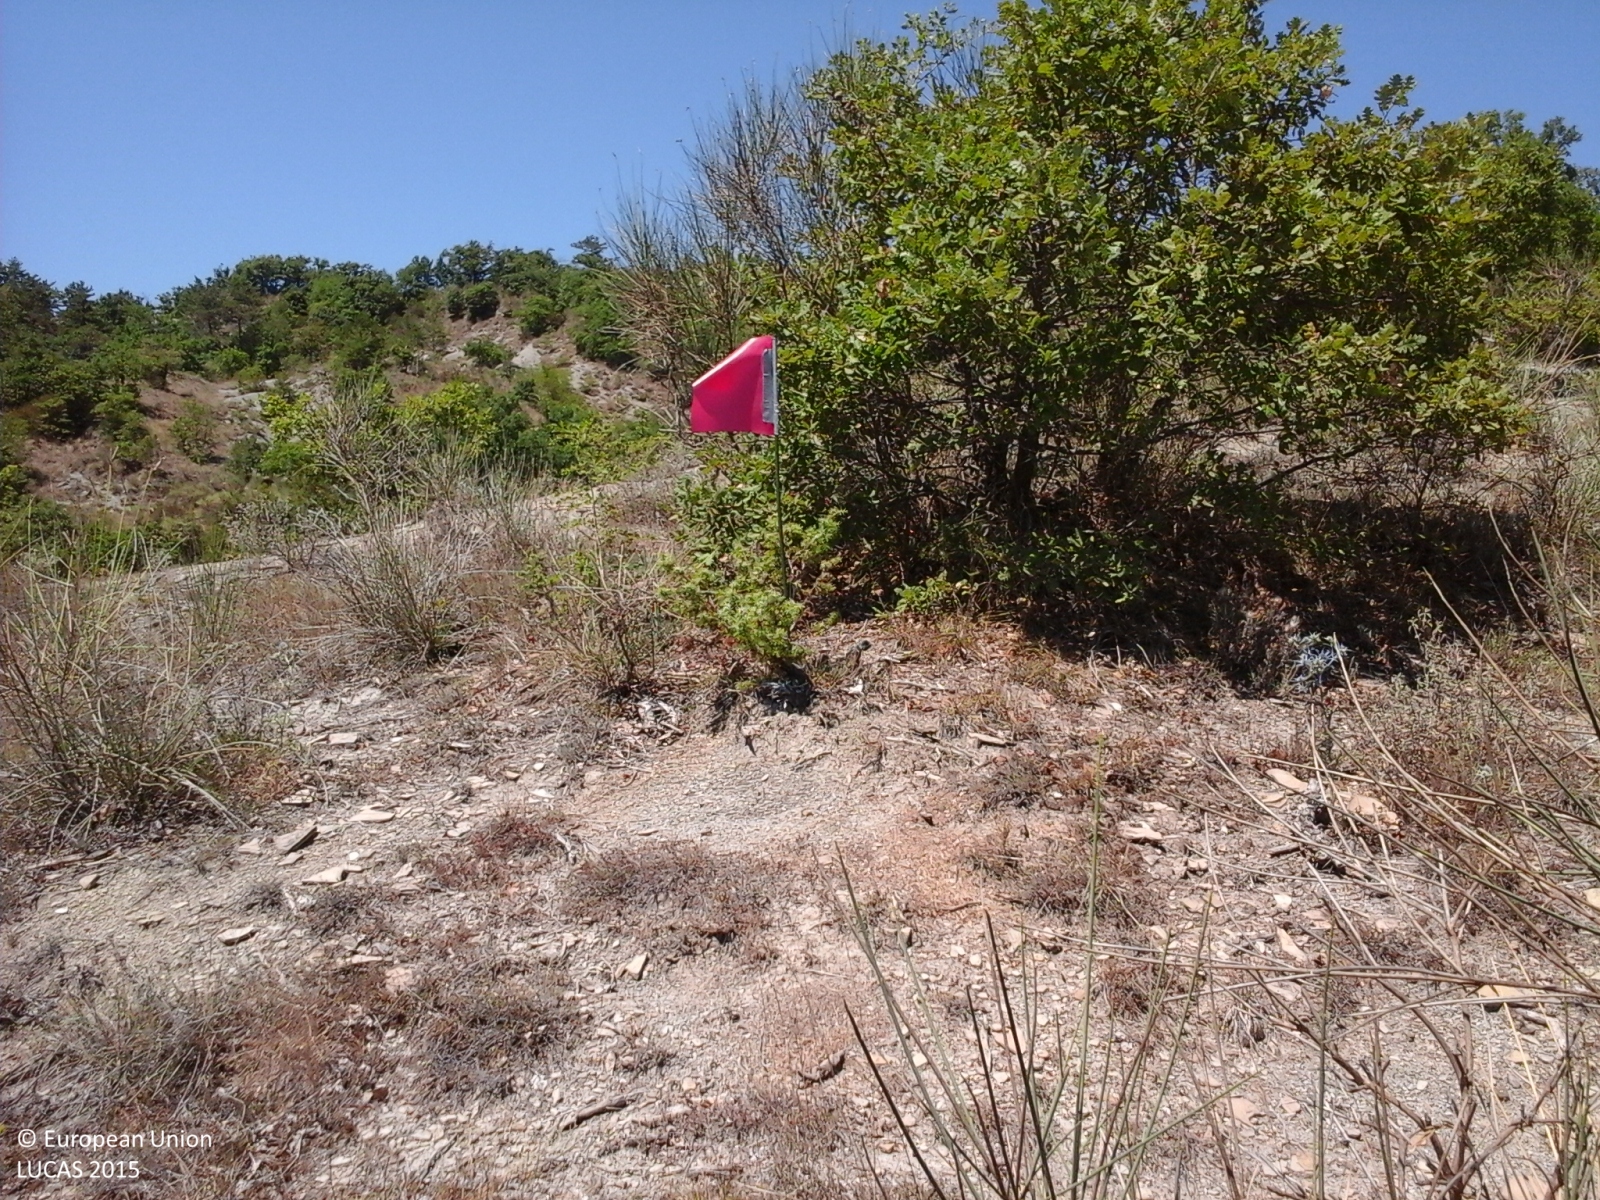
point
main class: Shrubland
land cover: Shrubland with sparse tree cover
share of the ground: > 75 %
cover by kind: shrubs 95 %, broadleaved forest trees 5 %
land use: Forestry
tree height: > 5 m
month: August
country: IT
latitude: 43.4772
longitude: 12.2810
